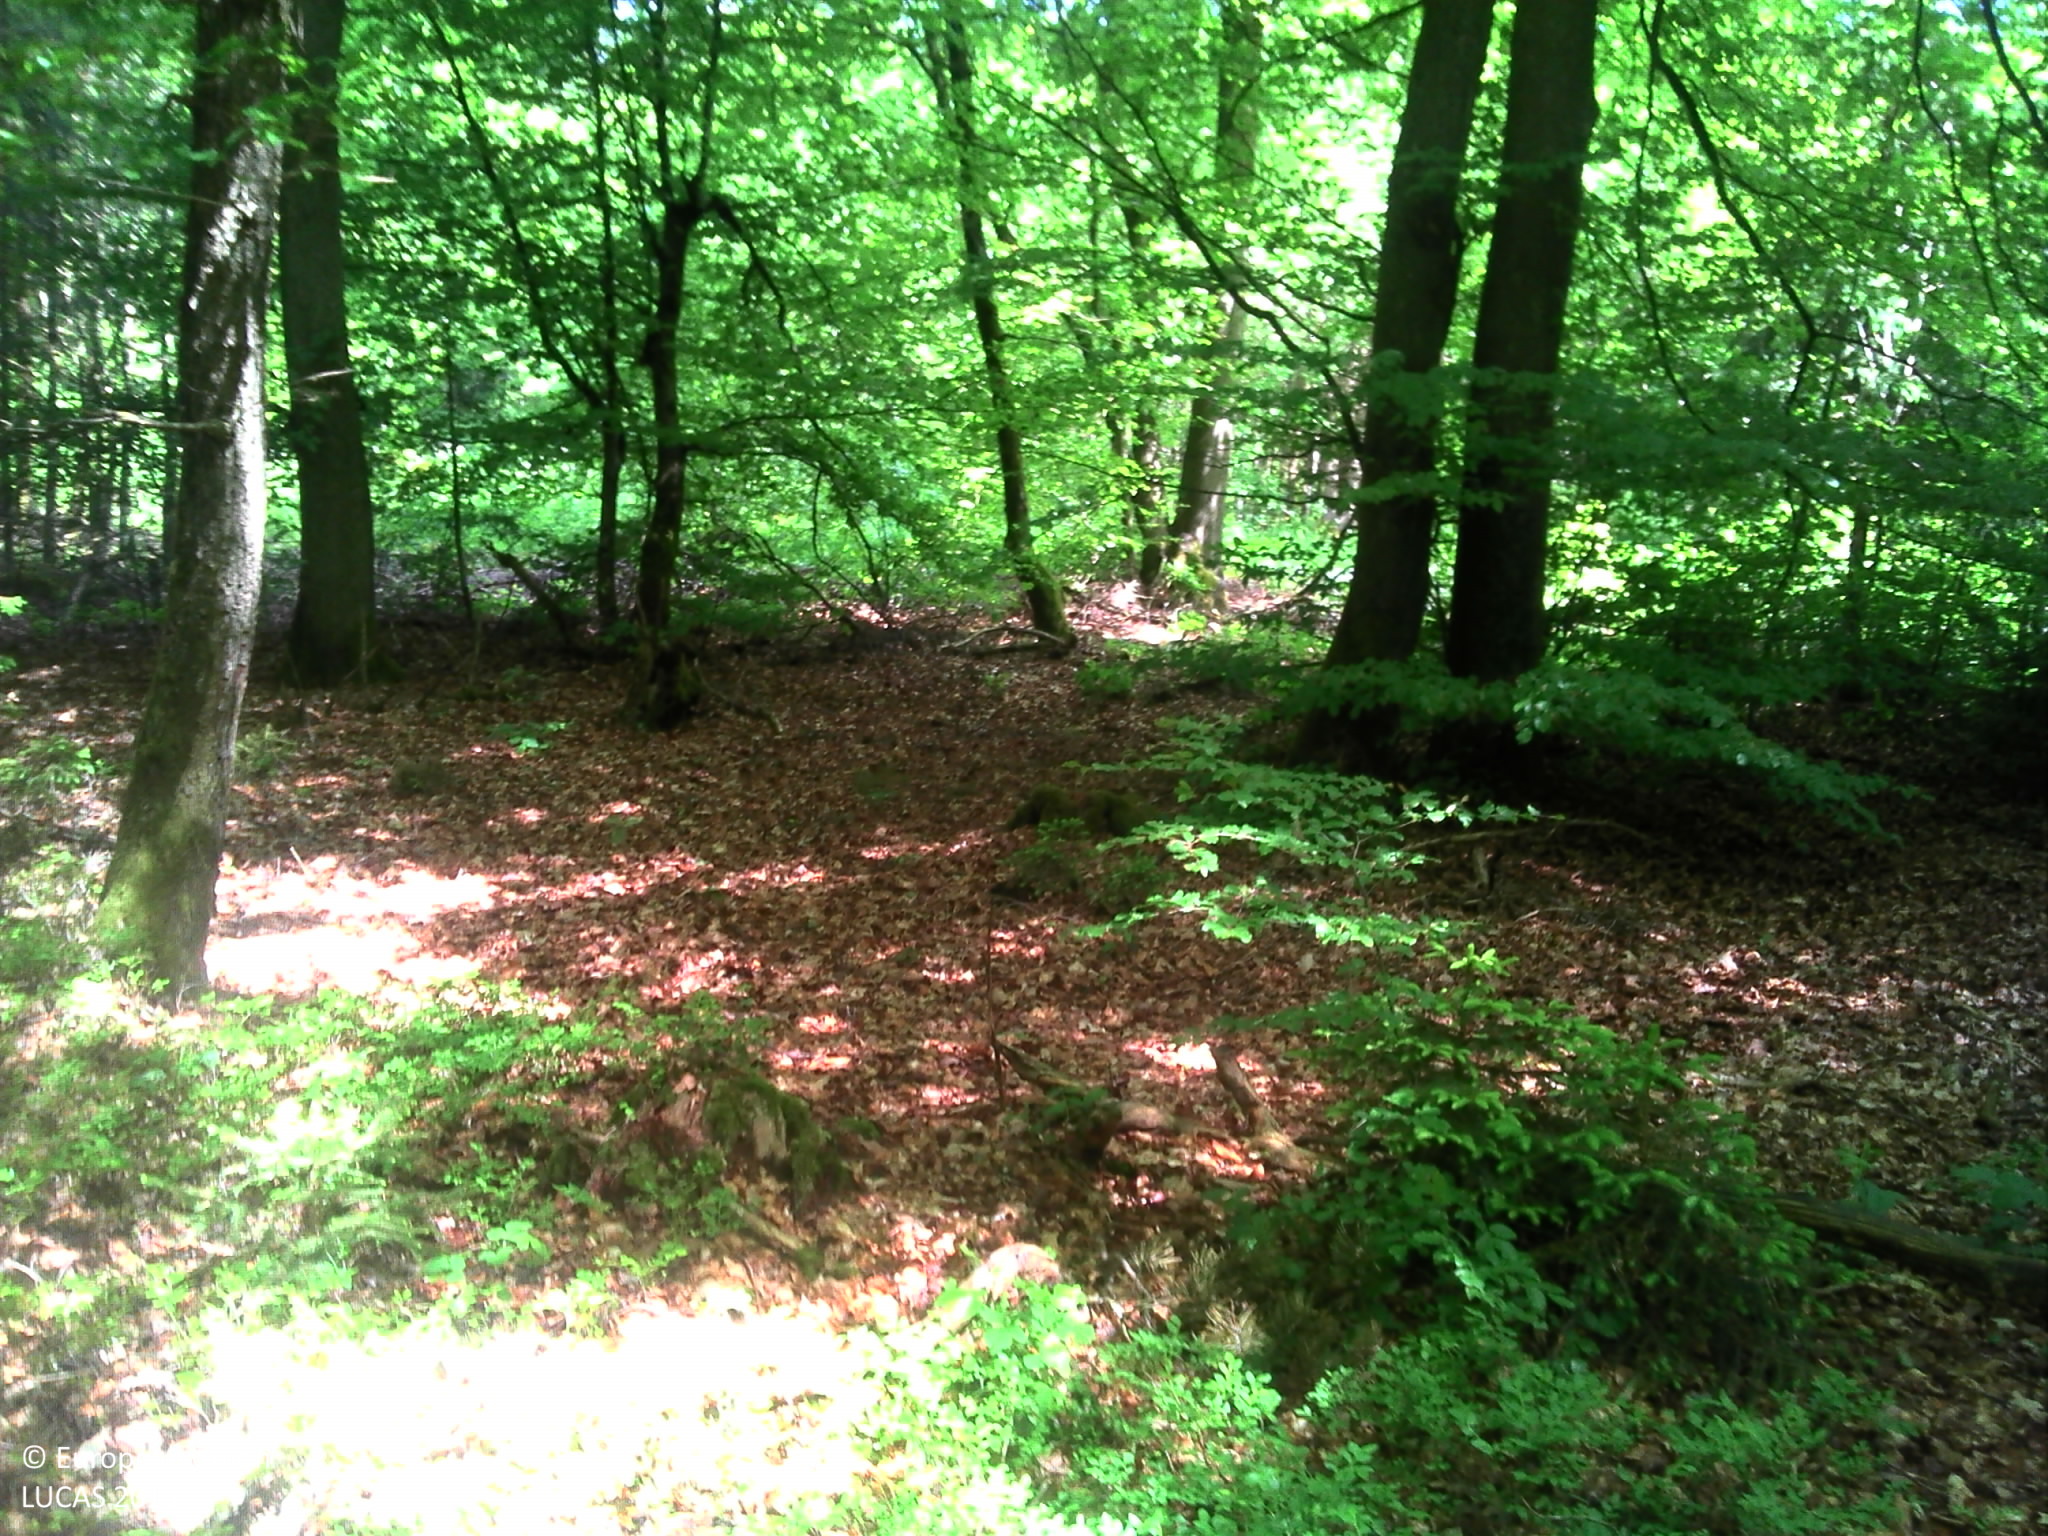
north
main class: Woodland
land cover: Broadleaved woodland
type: acidophilous oak and oak-birch forest
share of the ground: > 75 %
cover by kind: broadleaved forest trees 90 %, coniferous forest trees 5 %, herbaceous plants 5 %
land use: Forestry
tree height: > 5 m
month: May
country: LU
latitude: 49.8424
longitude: 5.9526
